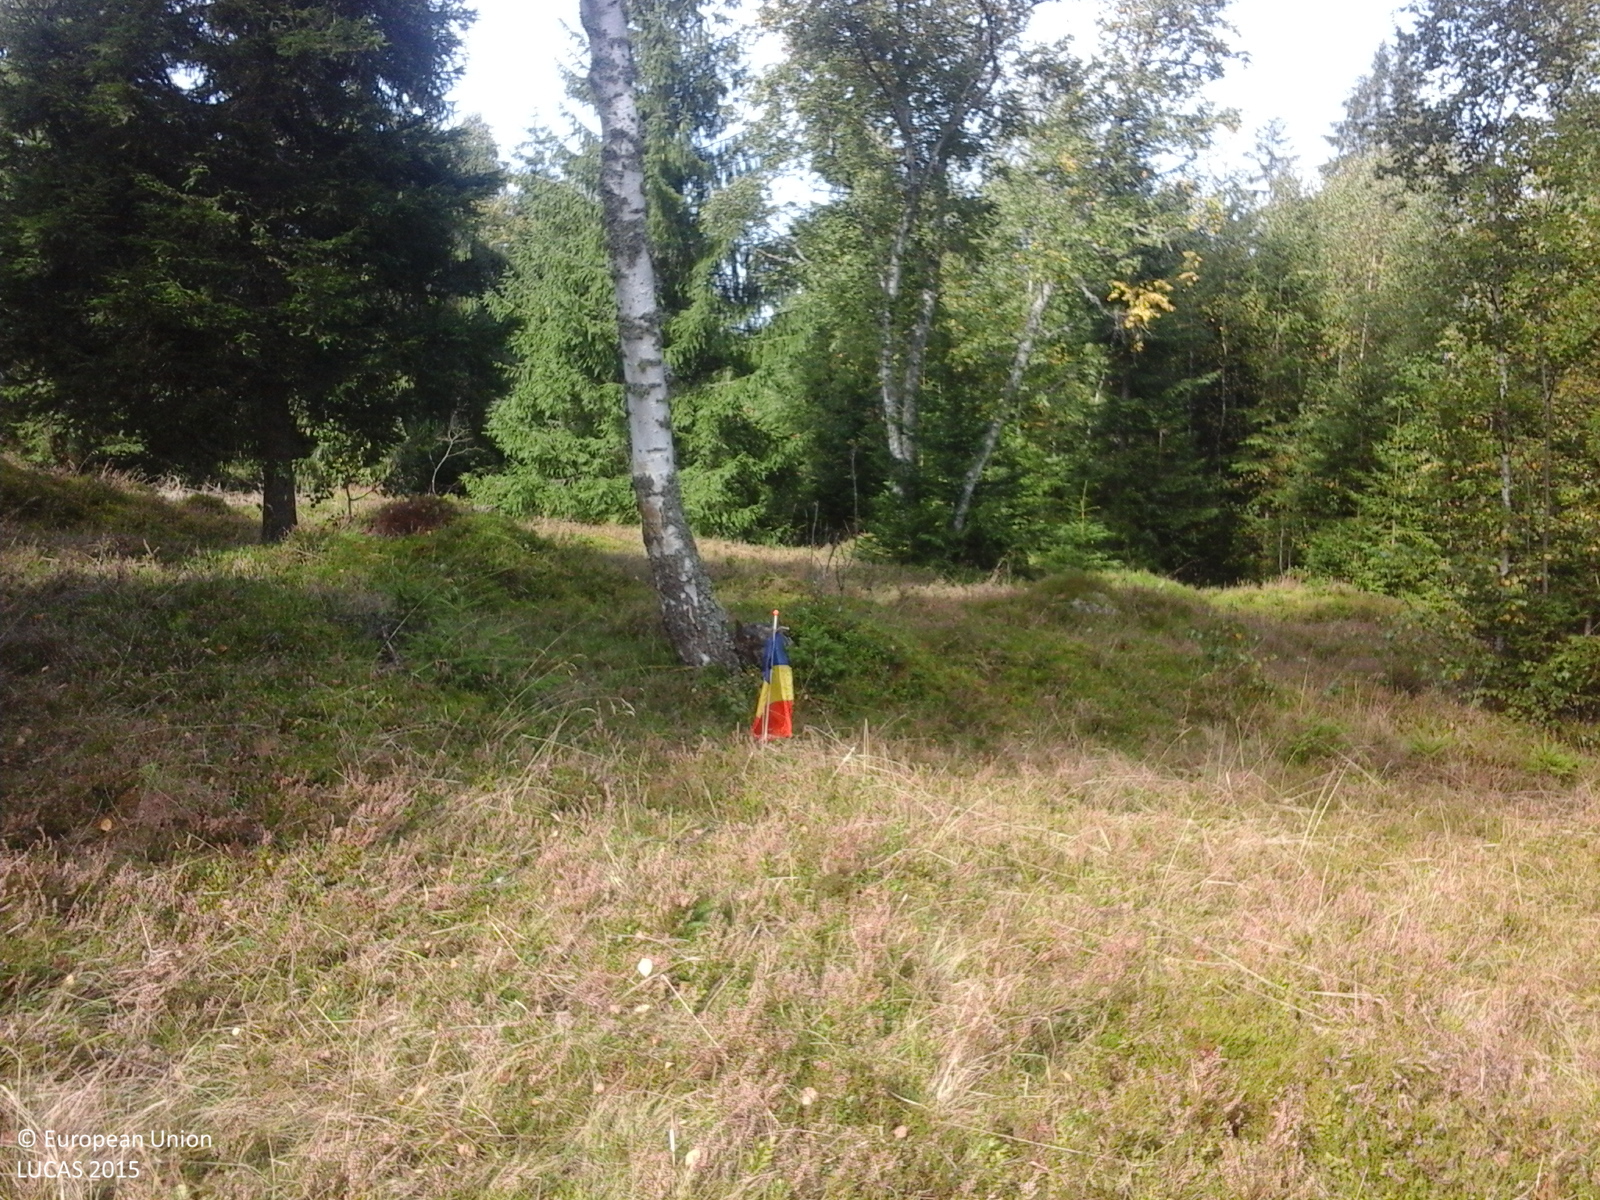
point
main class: Woodland
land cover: Spruce dominated mixed woodland
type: alpine coniferous forest
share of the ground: > 75 %
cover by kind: coniferous forest trees 50 %, broadleaved forest trees 30 %, herbaceous plants 15 %, shrubs 5 %
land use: Forestry
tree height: > 5 m
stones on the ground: < 10 %
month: September
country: RO
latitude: 46.7144
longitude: 23.0515
